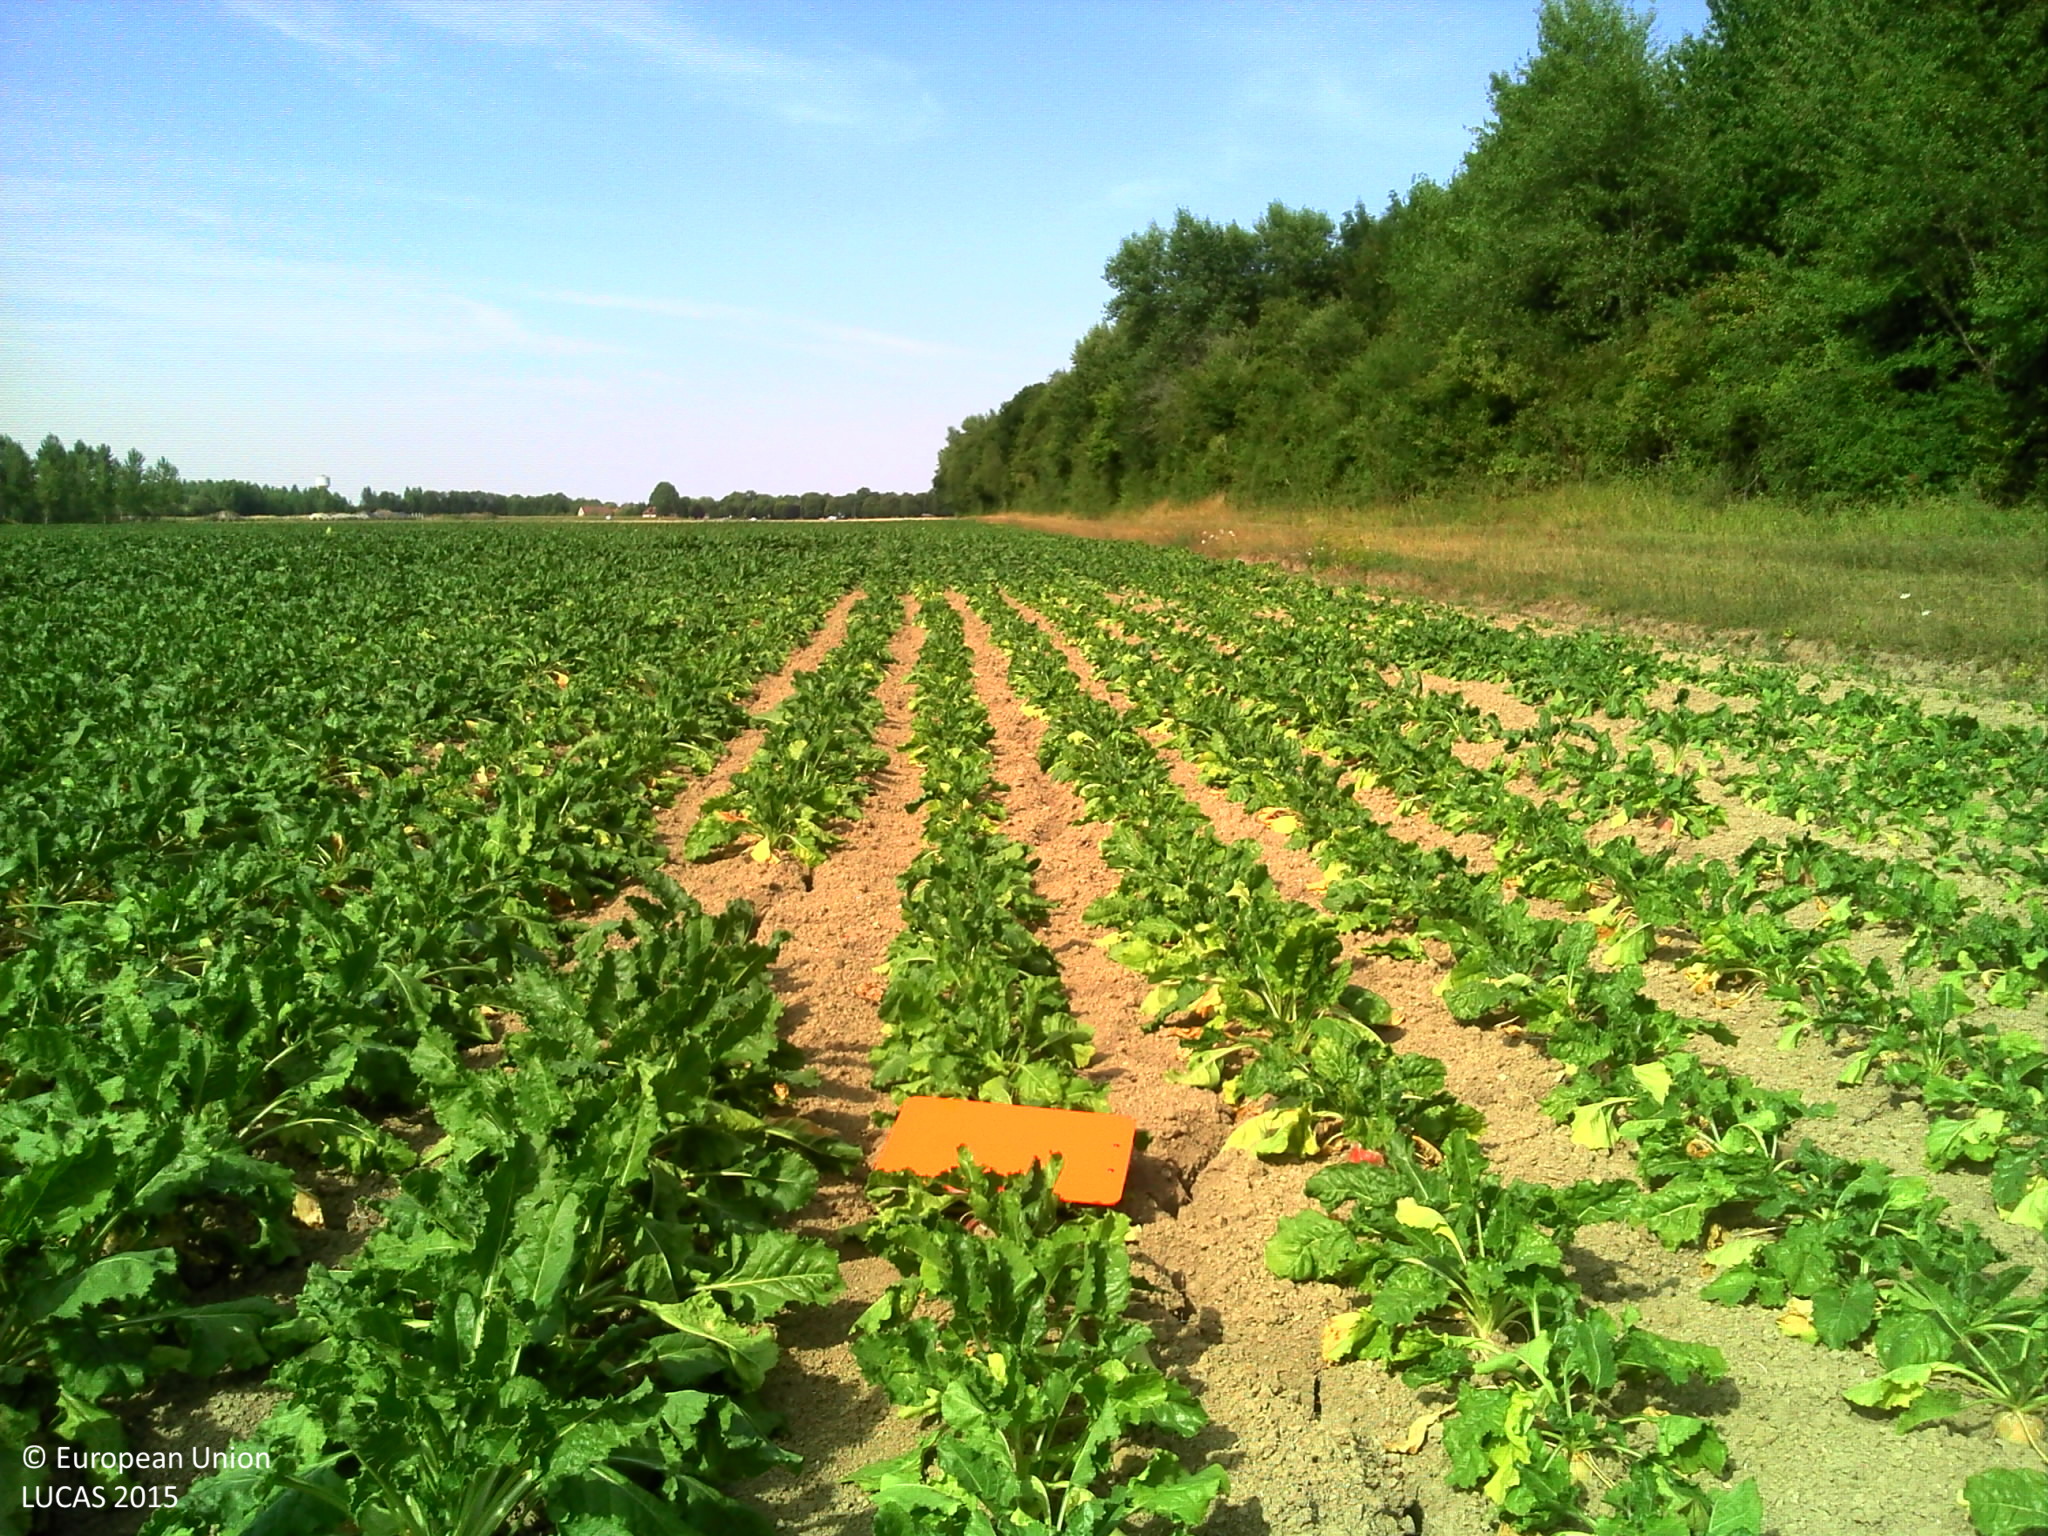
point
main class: Cropland
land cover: Sugar beet
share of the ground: > 75 %
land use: Agriculture (excluding fallow land and kitchen gardens)
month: July
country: FR
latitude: 48.5724
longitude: 3.8013
